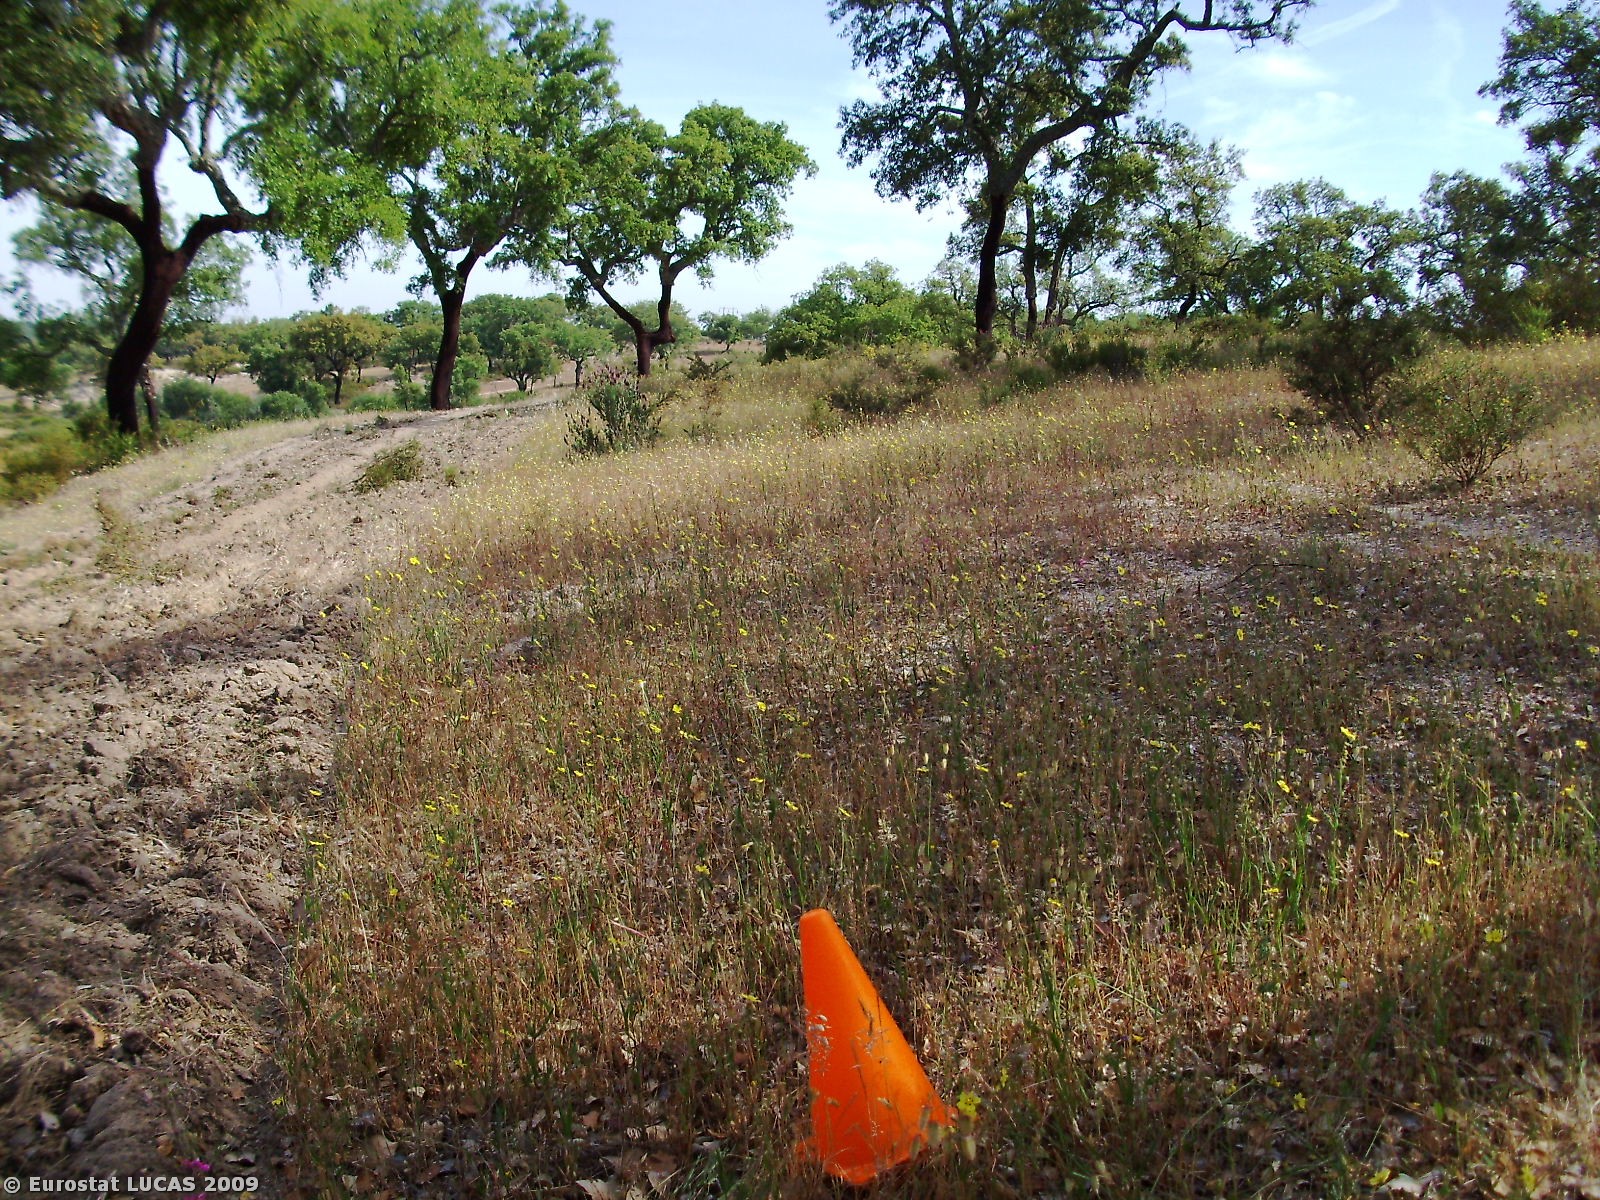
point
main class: Woodland
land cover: Broadleaved woodland
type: broadleaved evergreen forest
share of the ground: 50 - 75 %
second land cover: Spontaneously vegetated surfaces
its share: 25 - 50 %
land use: Forestry
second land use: Fallow land
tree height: > 5 m
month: May
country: PT
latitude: 39.0633
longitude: -8.0228
